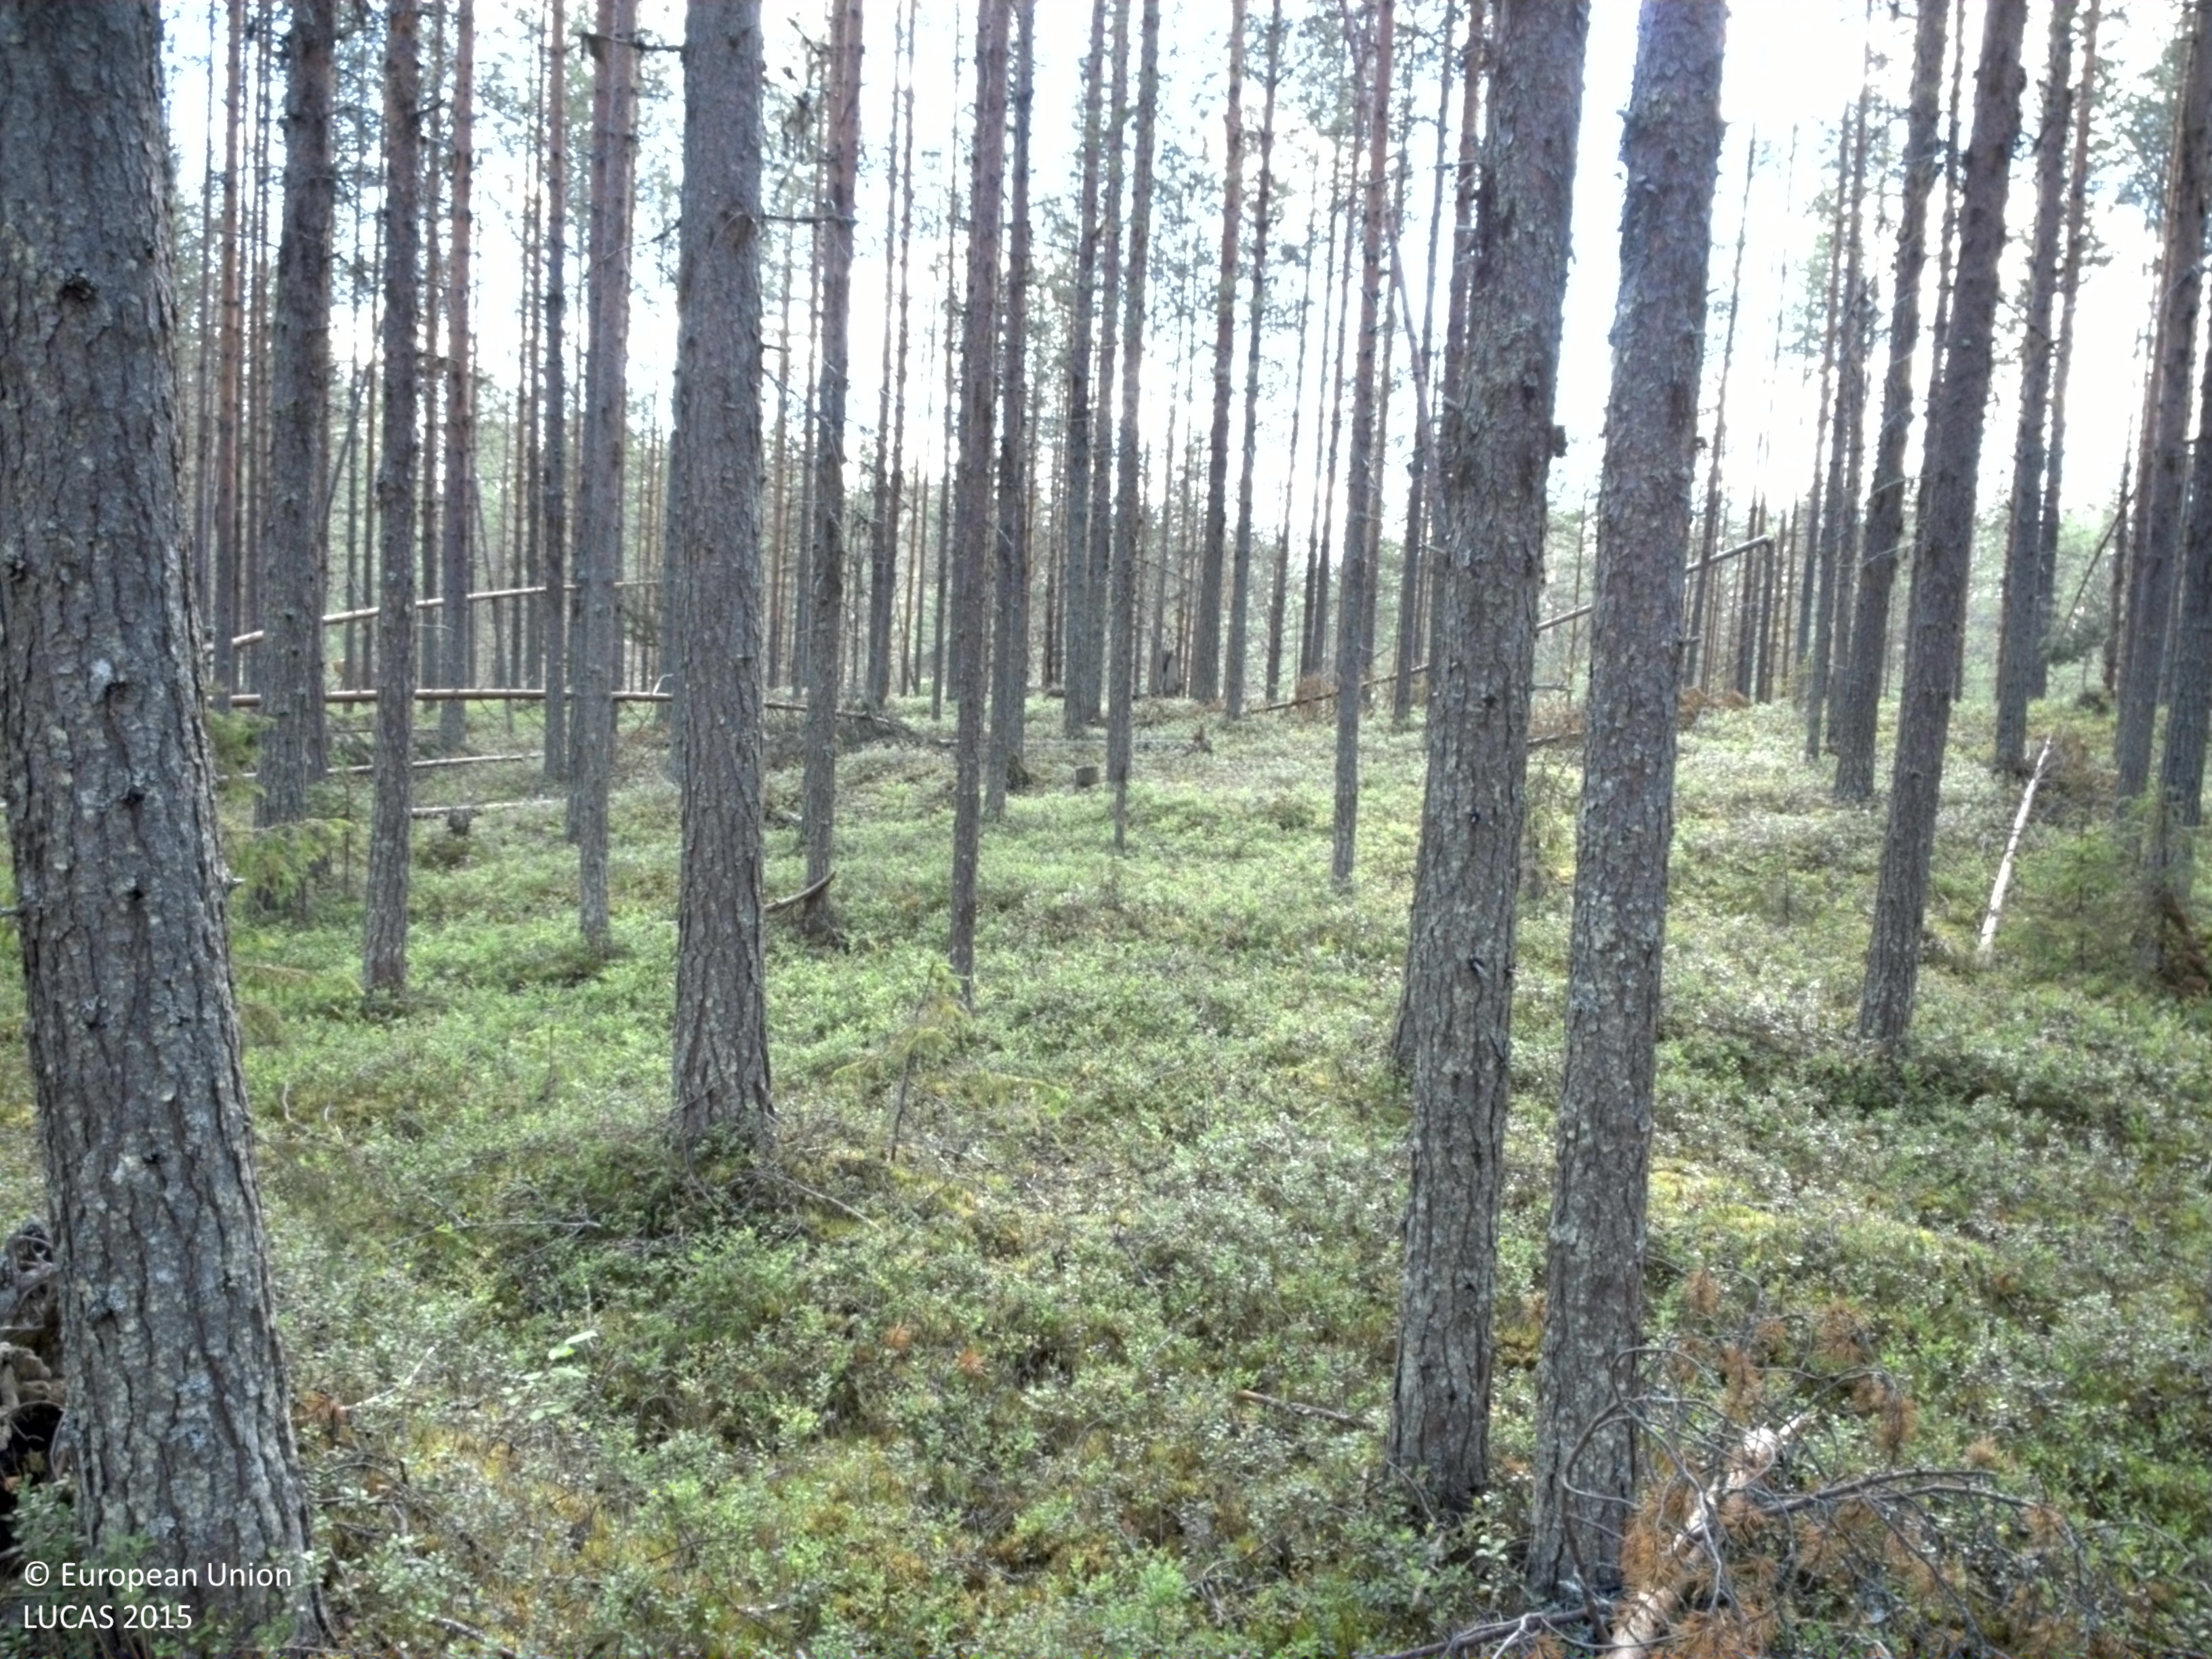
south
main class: Woodland
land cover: Pine dominated coniferous woodland
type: boreal forest
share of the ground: 25 - 50 %
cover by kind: shrubs 65 %, coniferous forest trees 35 %
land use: Forestry
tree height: > 5 m
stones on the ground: < 10 %
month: August
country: SE
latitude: 66.4988
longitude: 20.7671
